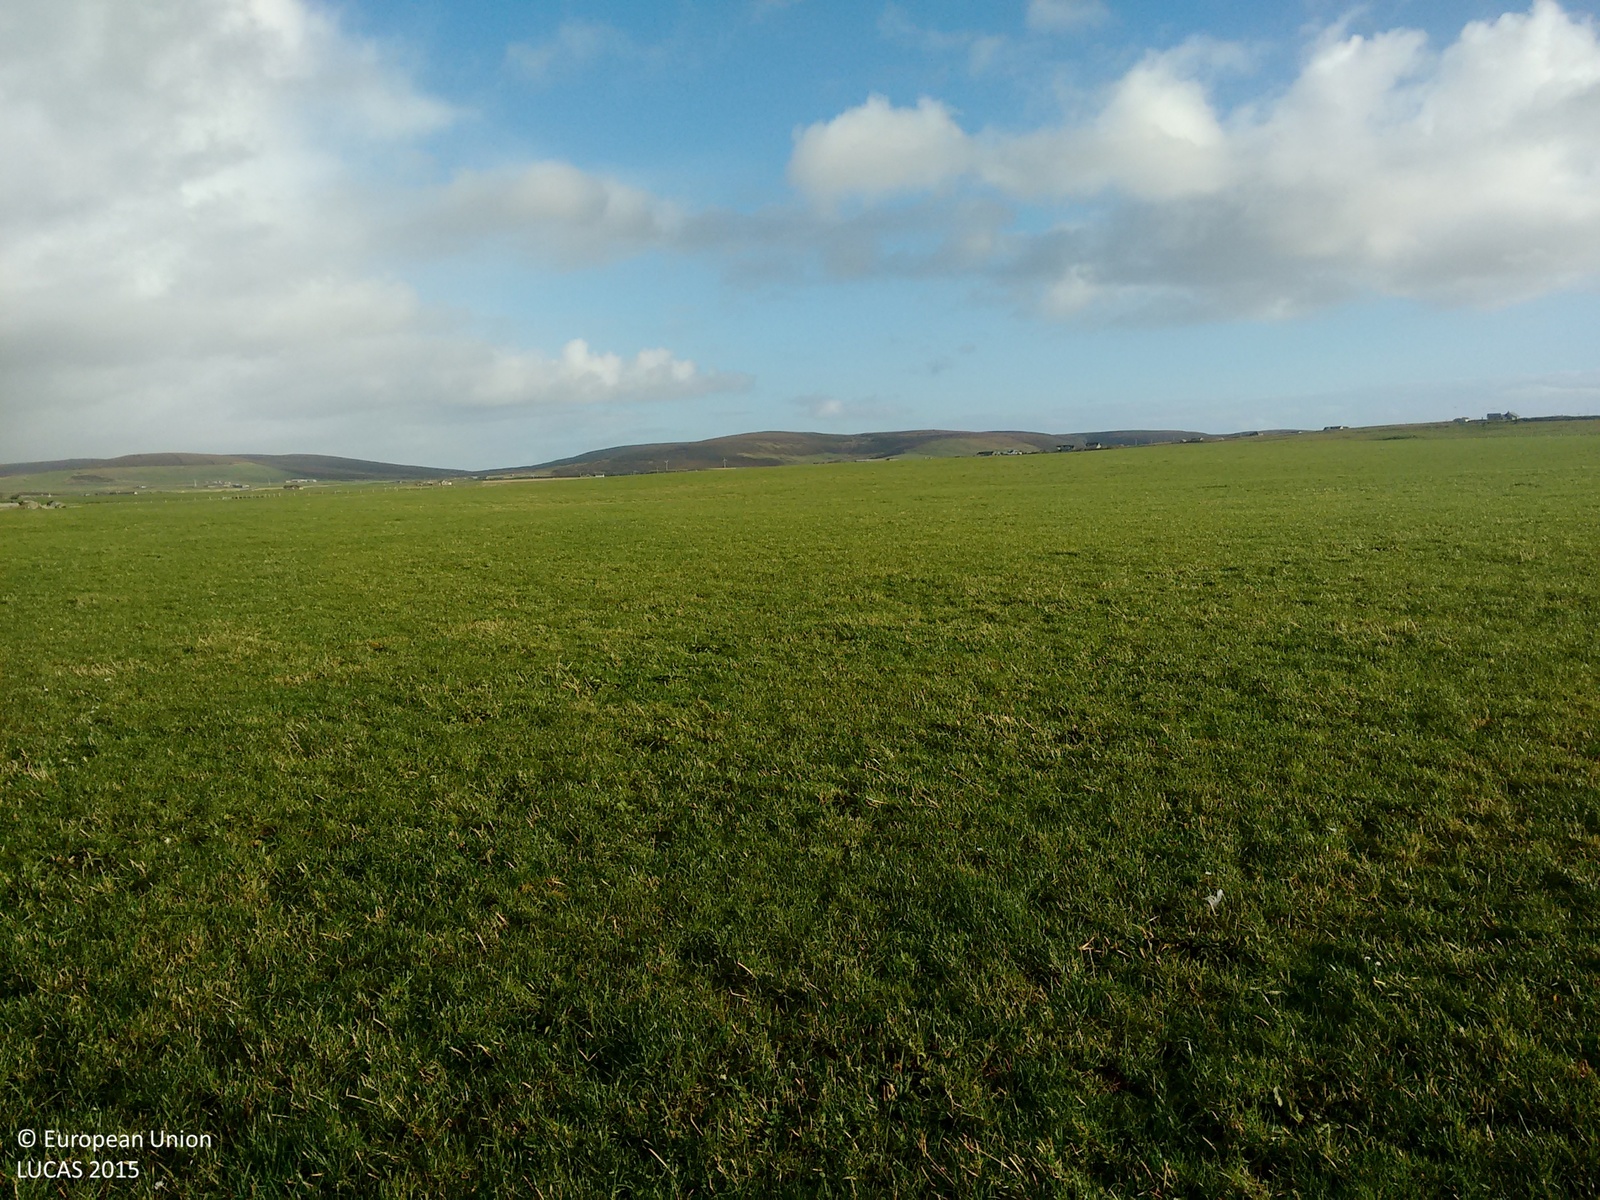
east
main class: Grassland
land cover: Grassland without tree/shrub cover
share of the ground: > 75 %
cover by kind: herbaceous plants 100 %
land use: Agriculture (excluding fallow land and kitchen gardens)
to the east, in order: Grassland without tree/shrub cover
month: November
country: GB
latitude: 59.0256
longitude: -3.2083
